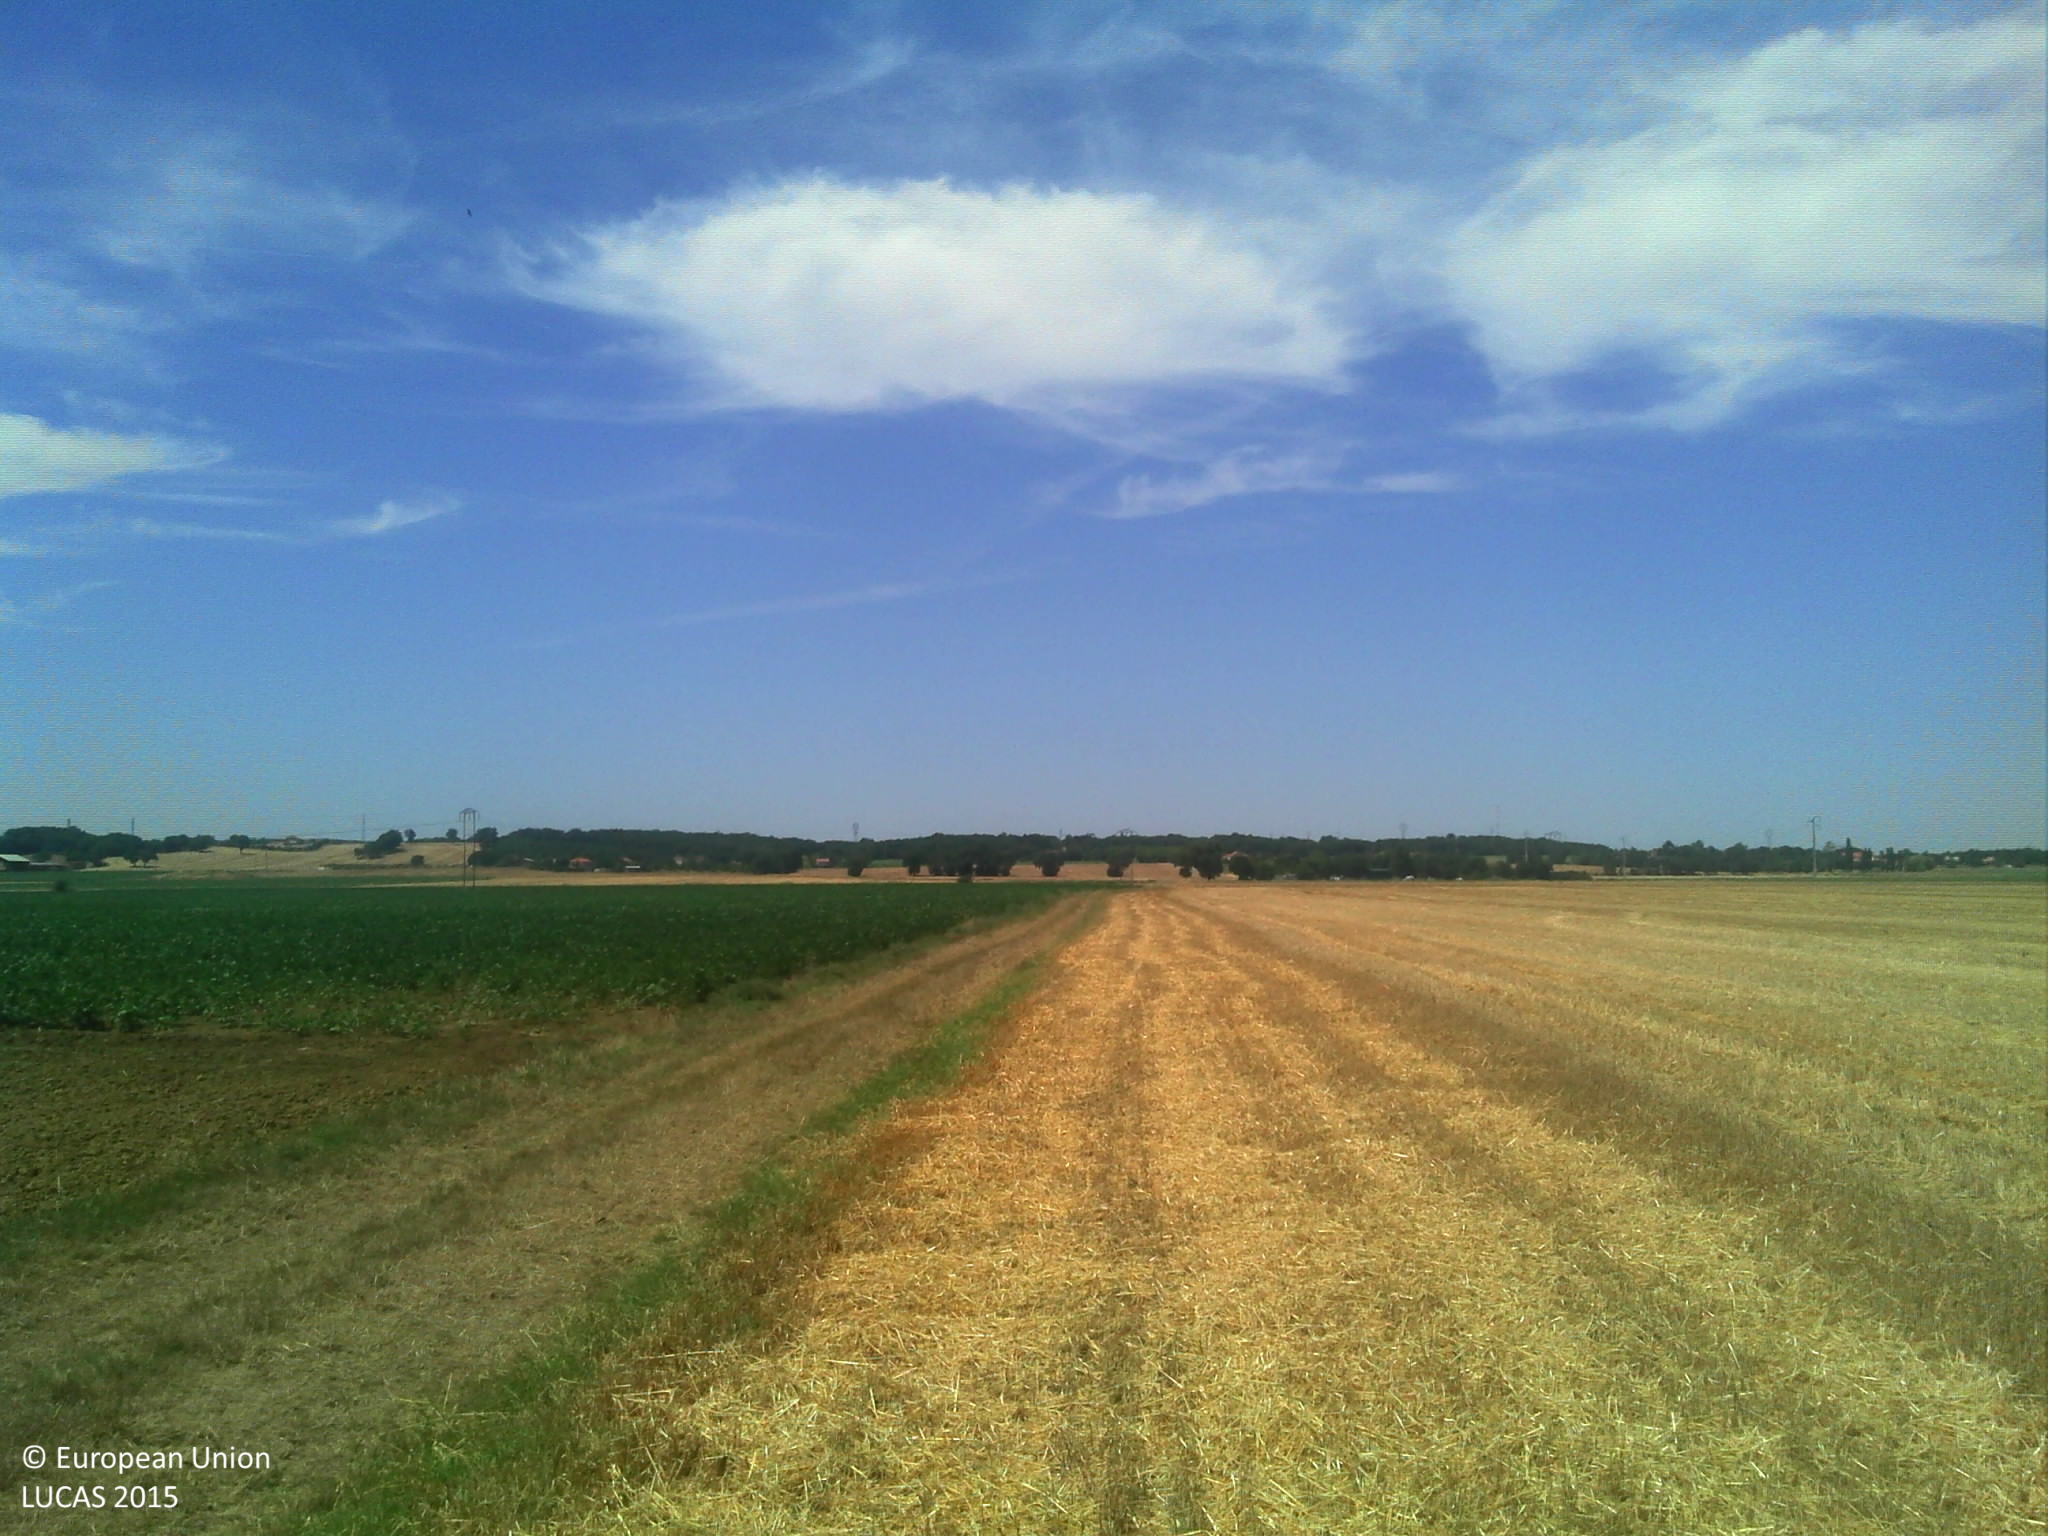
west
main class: Cropland
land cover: Common wheat
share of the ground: > 75 %
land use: Agriculture (excluding fallow land and kitchen gardens)
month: July
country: FR
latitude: 43.4303
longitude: 1.3931
